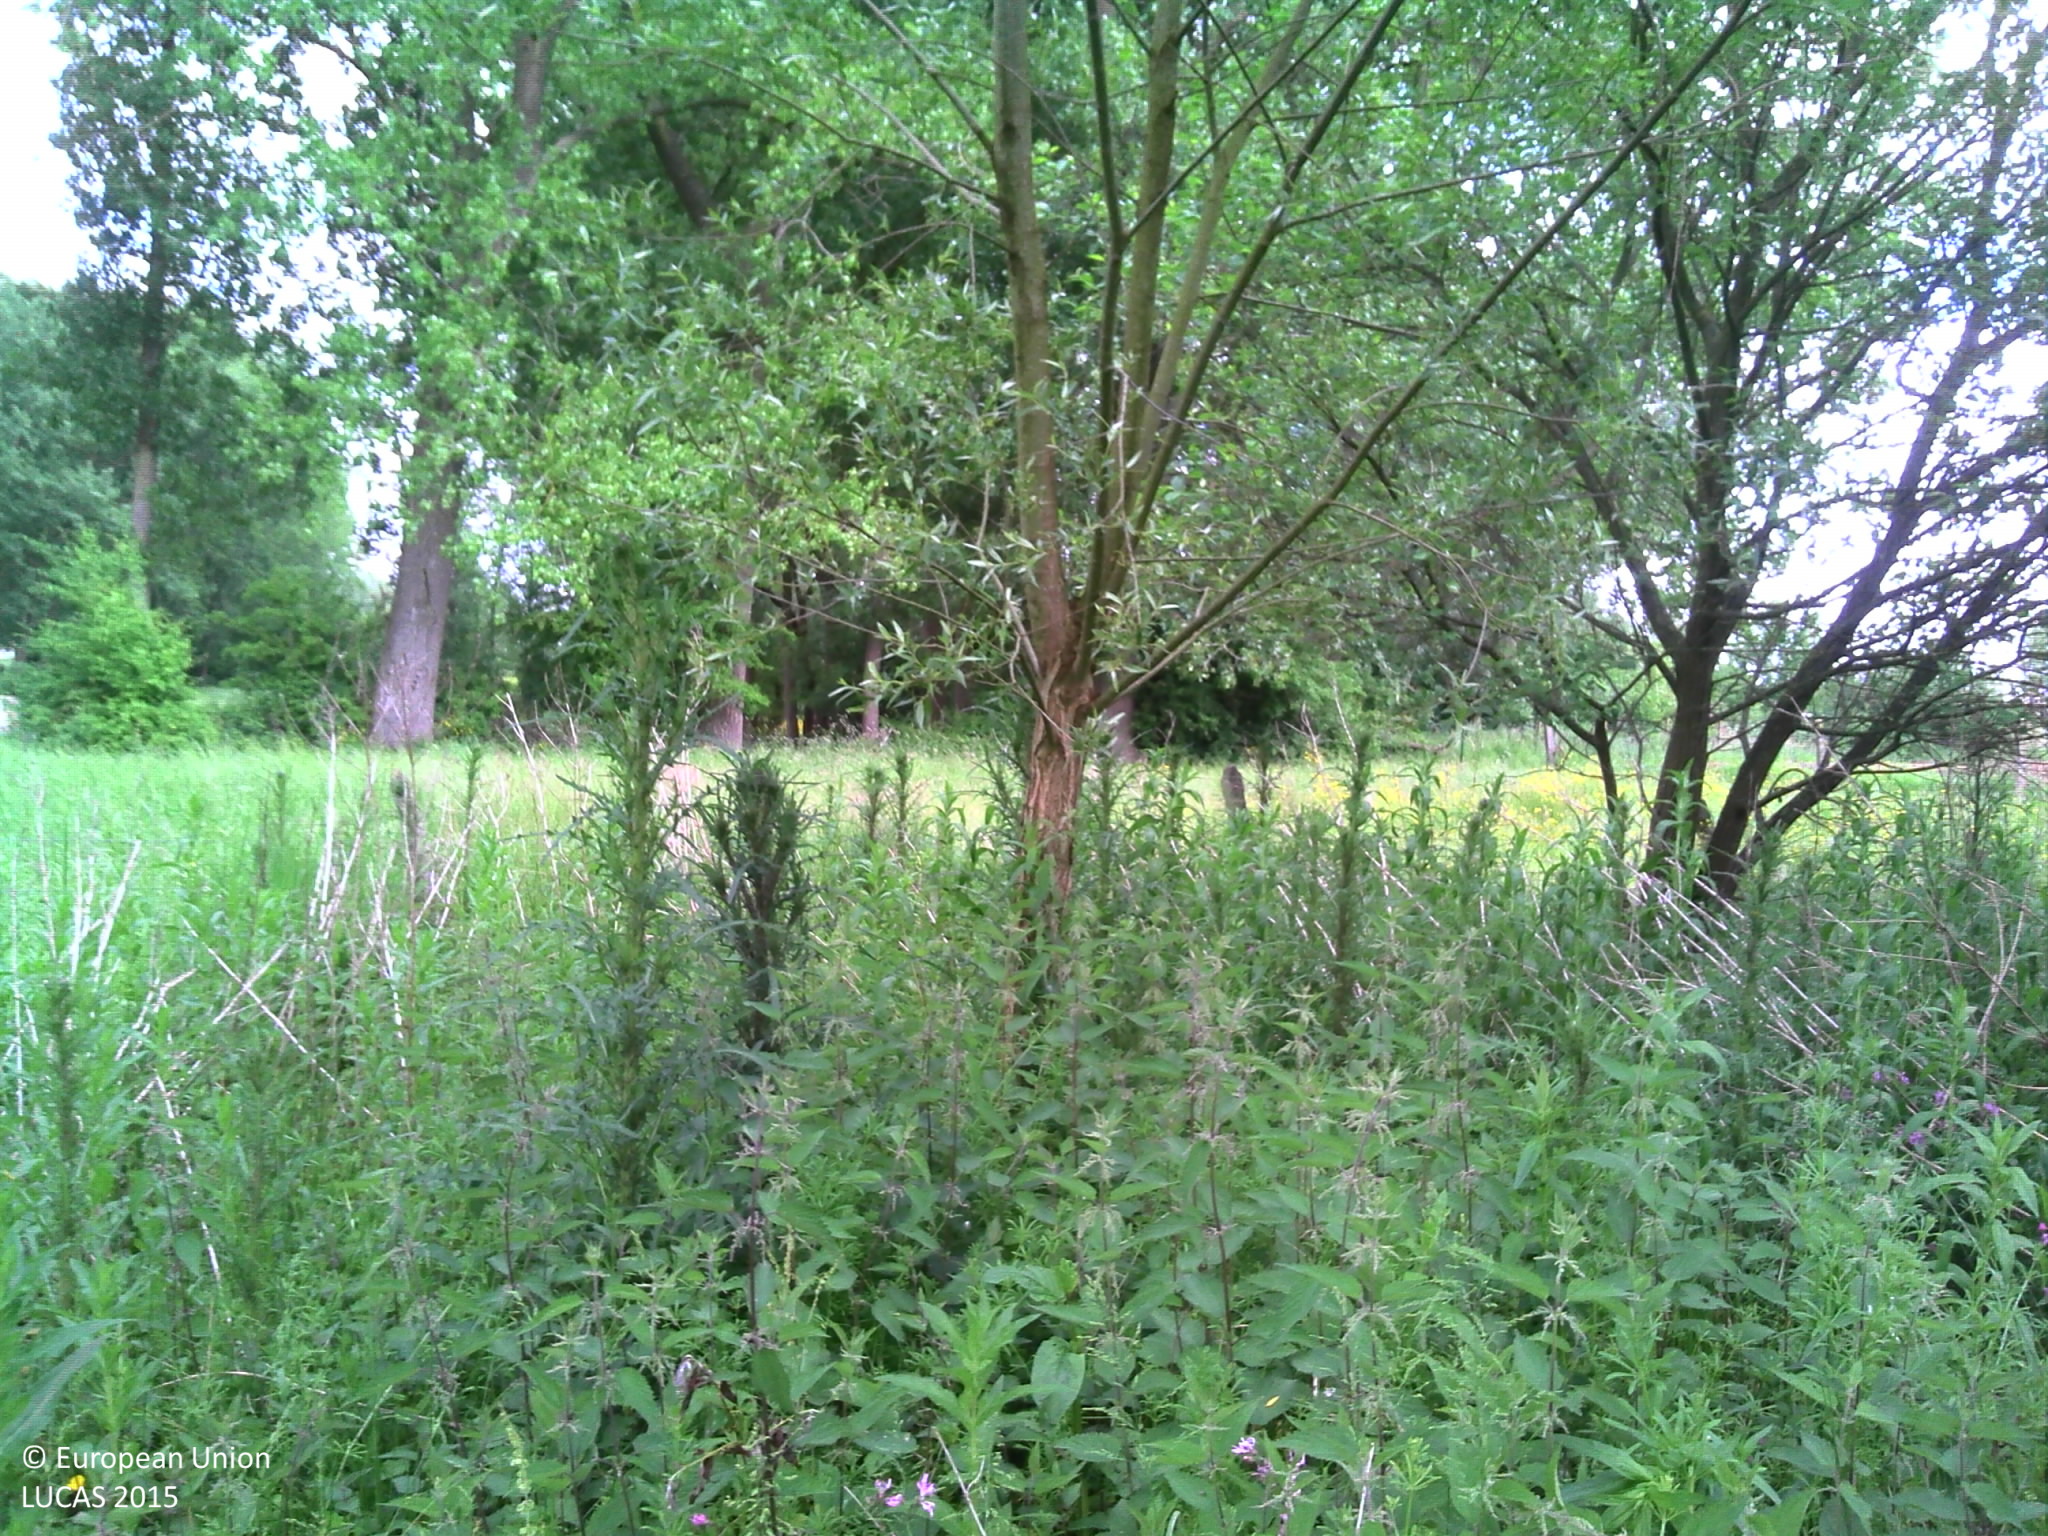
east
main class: Woodland
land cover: Broadleaved woodland
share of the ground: 50 - 75 %
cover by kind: broadleaved forest trees 60 %, herbaceous plants 40 %
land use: Forestry
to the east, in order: Broadleaved woodland; Fences; Grassland without tree/shrub cover; Fences; Broadleaved woodland; Fences; Grassland without tree/shrub cover; Fences; Grassland with sparse tree/shrub cover; Fences; Artificial constructions in urban areas; Grassland without tree/shrub cover
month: June
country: BE
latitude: 50.7758
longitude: 3.8531
